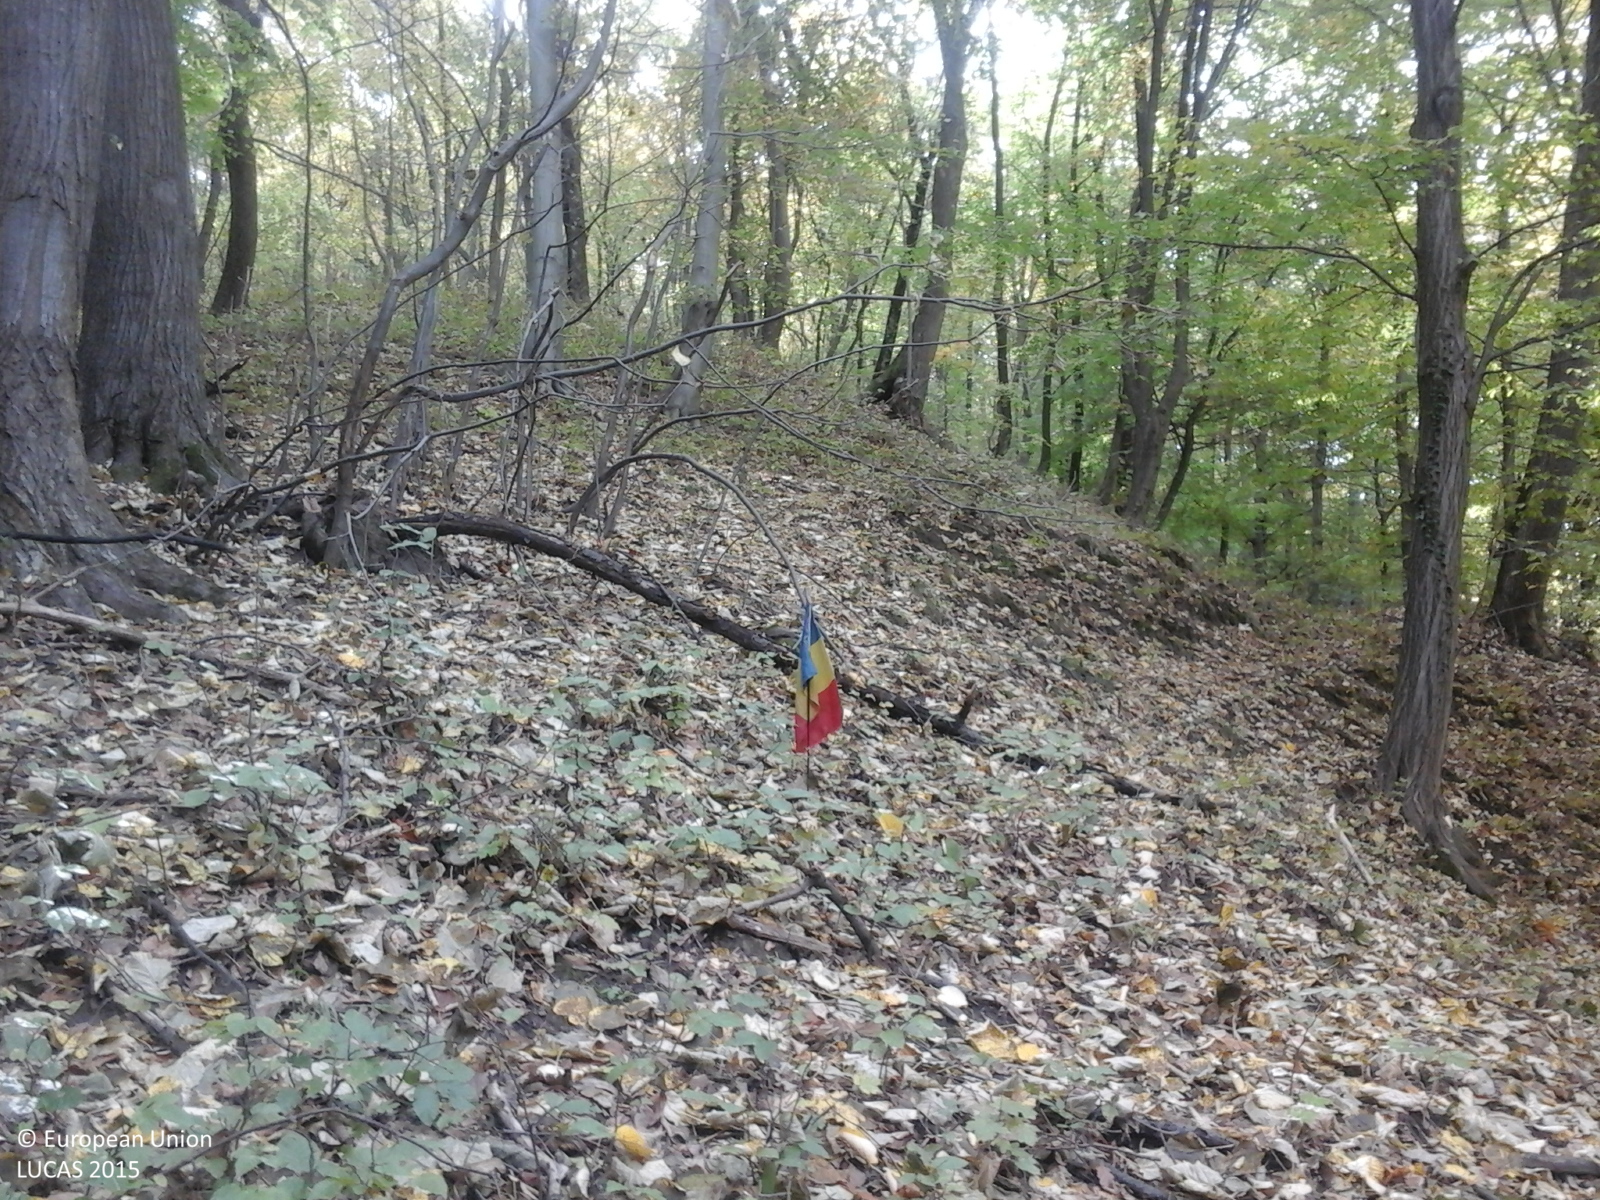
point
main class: Woodland
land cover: Broadleaved woodland
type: beech forest
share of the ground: > 75 %
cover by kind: broadleaved forest trees 100 %
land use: Forestry
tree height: > 5 m
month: October
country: RO
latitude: 45.0389
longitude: 26.2754
